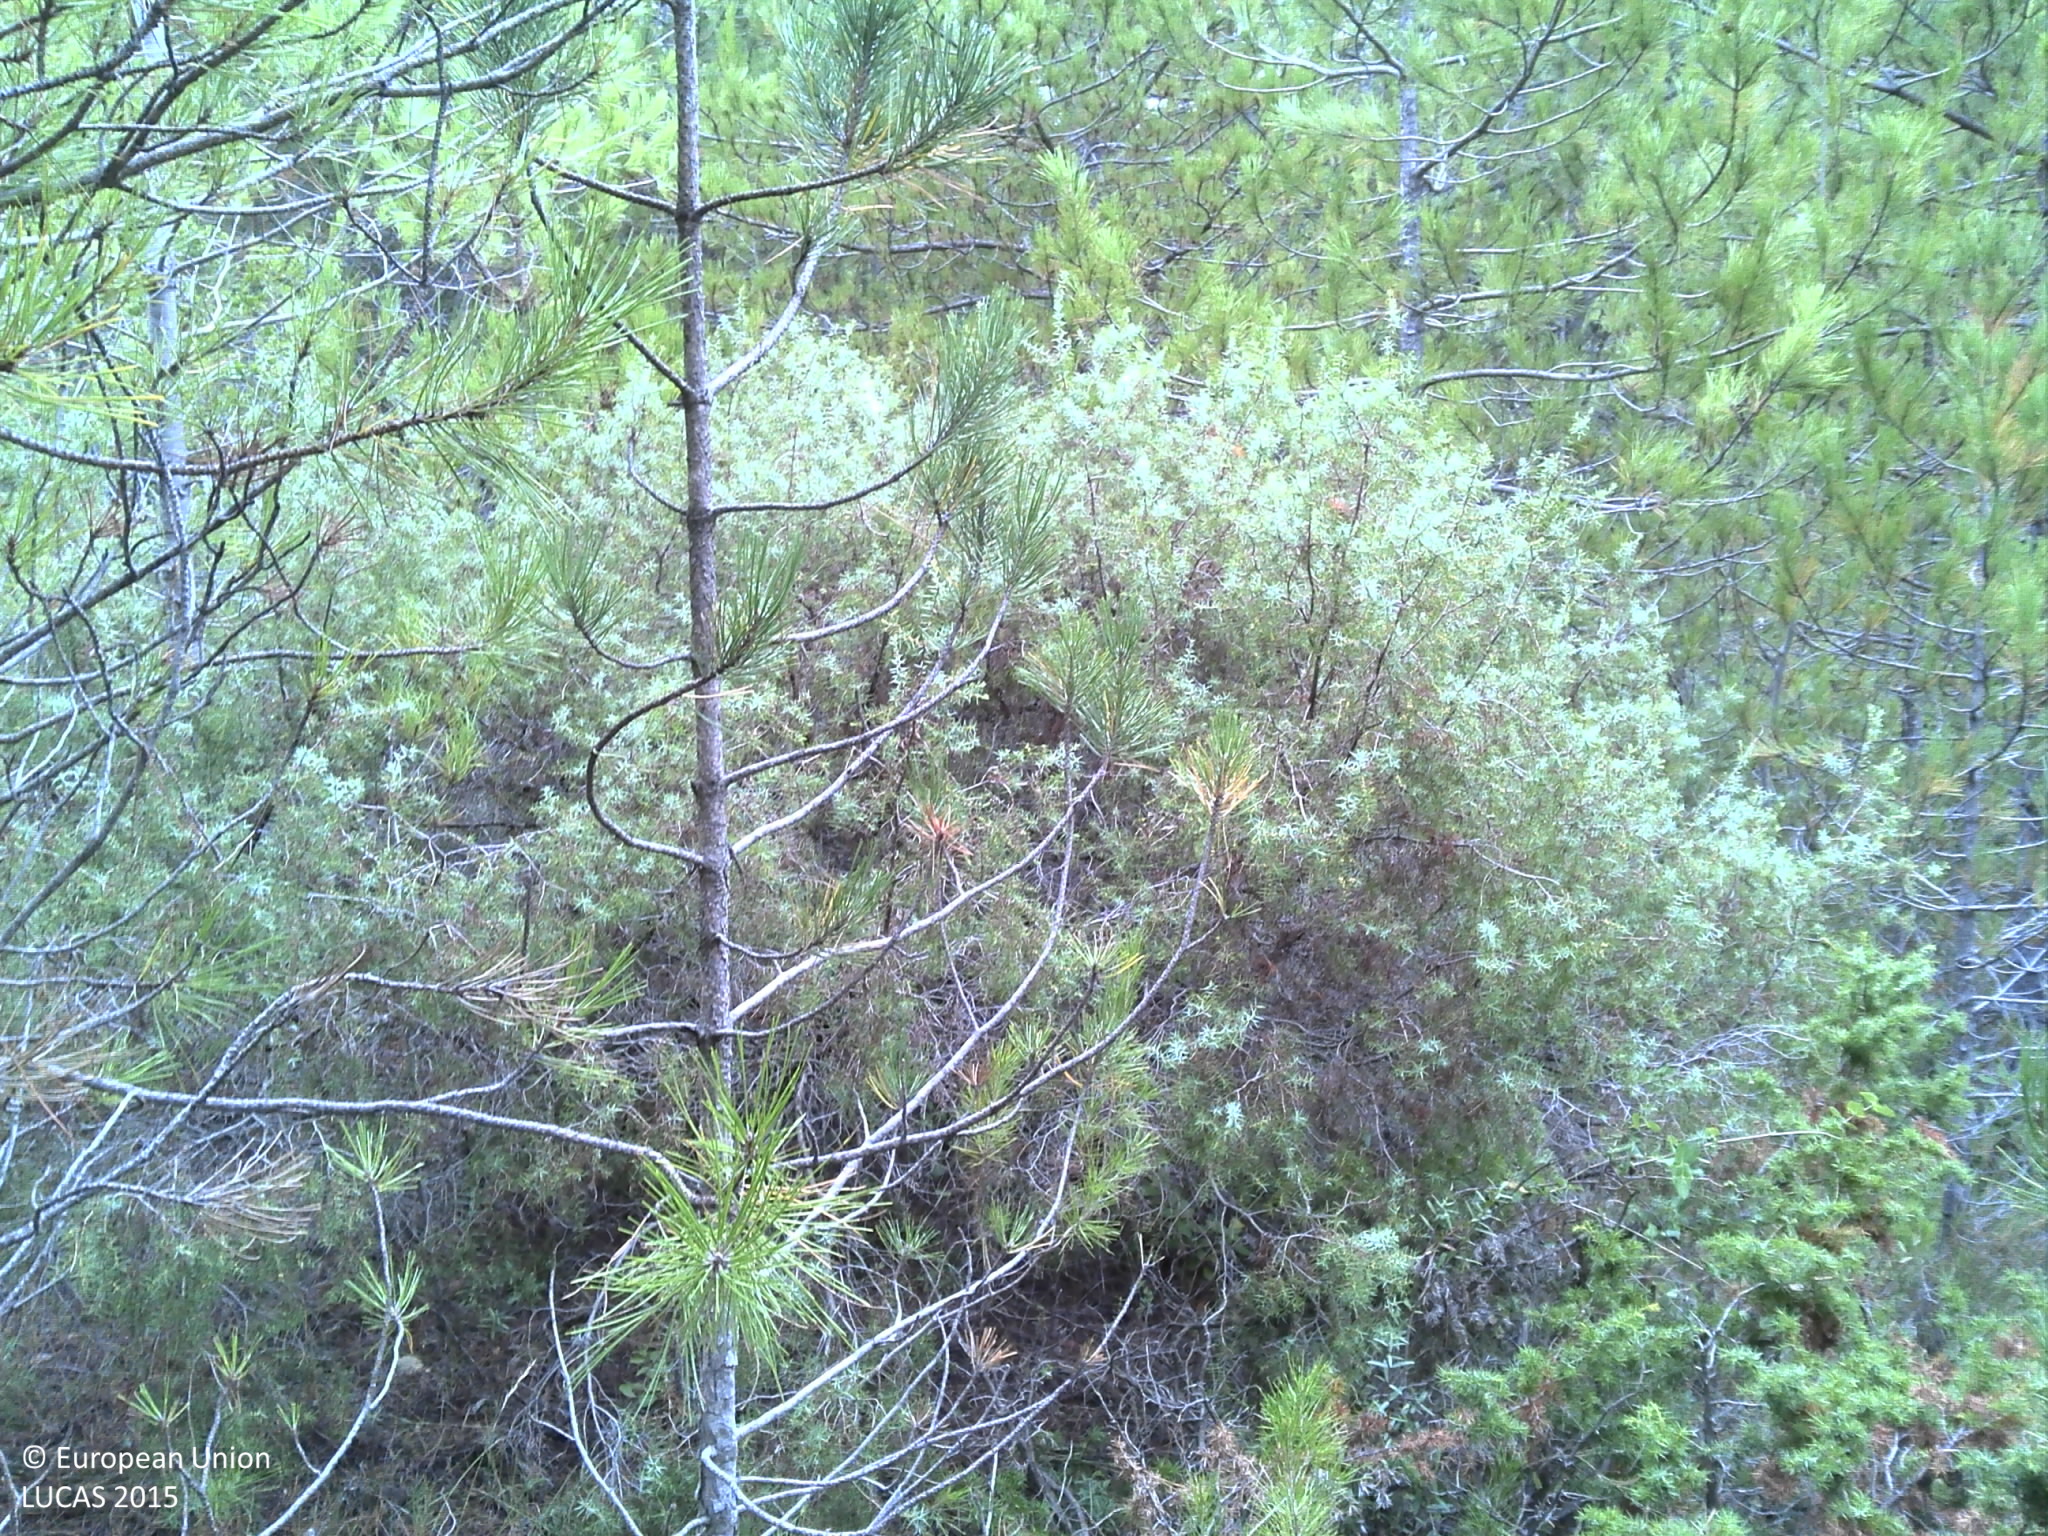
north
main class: Woodland
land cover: Pine dominated coniferous woodland
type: coniferous forest of the mediterranean region
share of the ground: > 75 %
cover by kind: coniferous forest trees 75 %, shrubs 10 %, herbaceous plants 5 %, lichens and mosses 5 %, unconsolidated bare surface 5 %
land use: Semi-natural and natural areas not in use
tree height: > 5 m
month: October
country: FR
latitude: 43.3323
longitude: 2.6947
